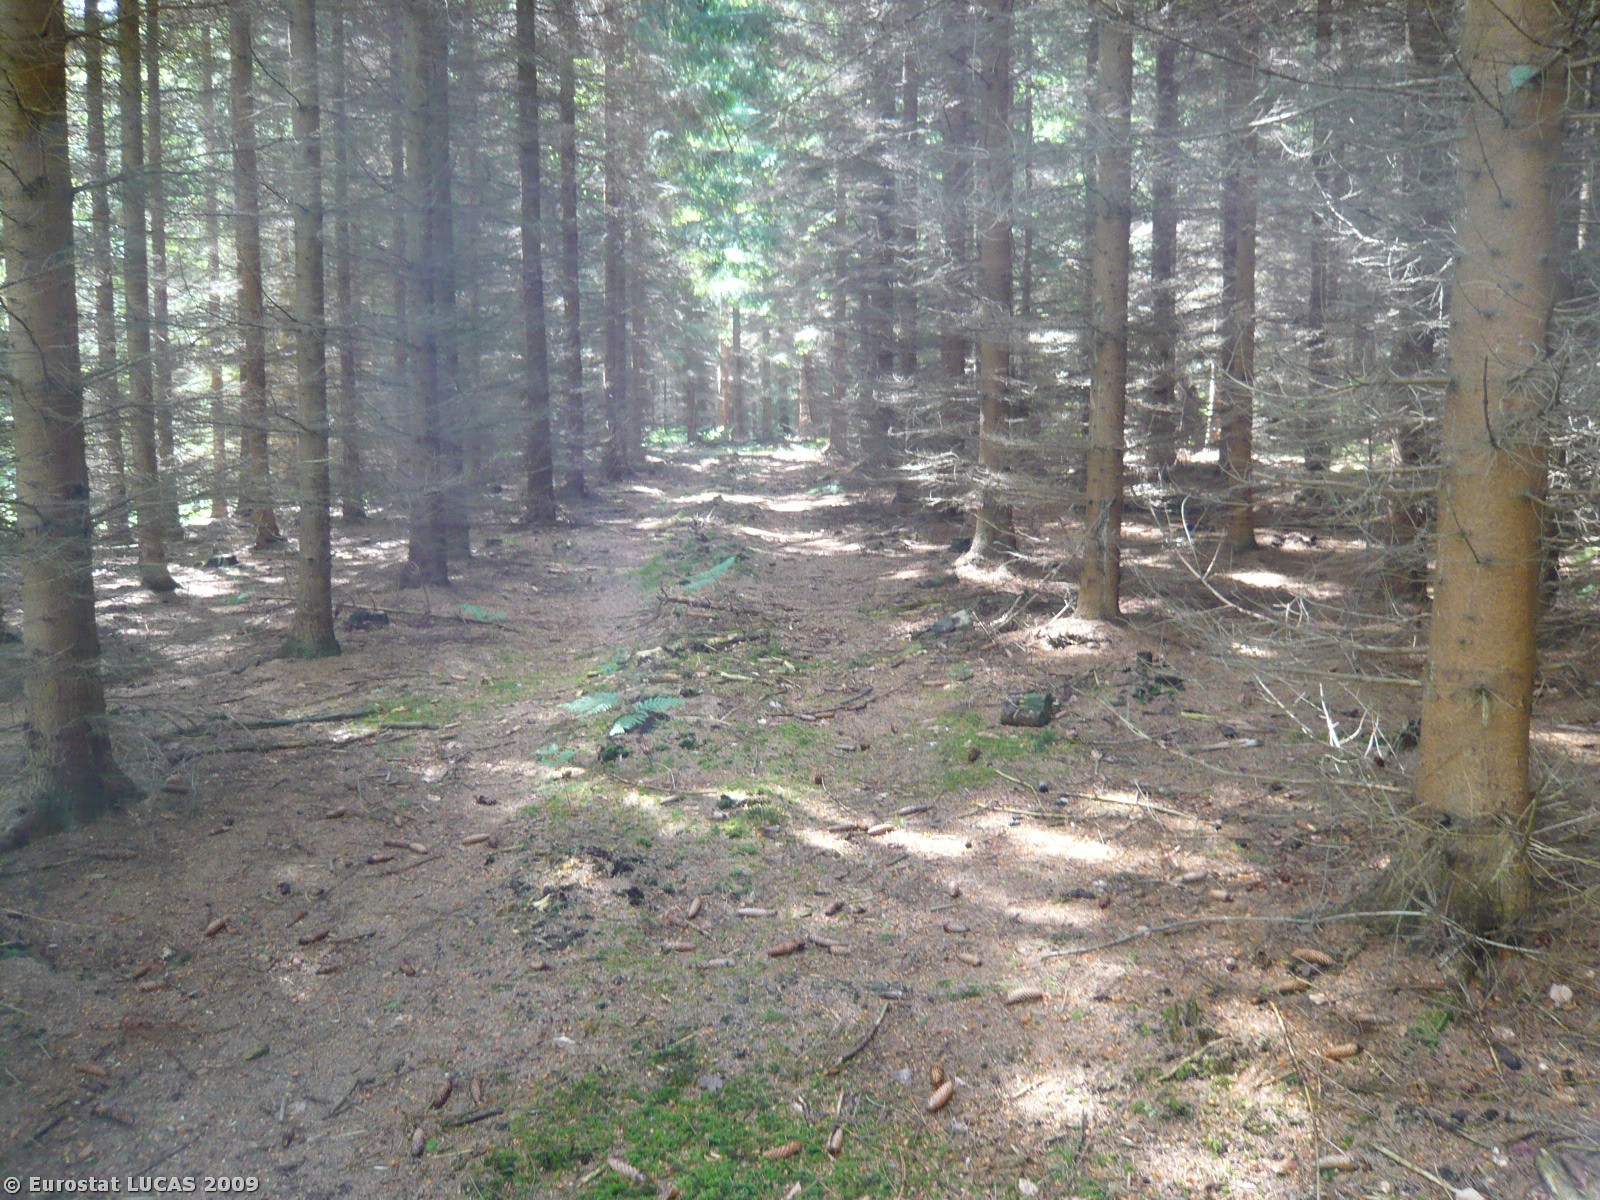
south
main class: Woodland
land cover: Coniferous woodland
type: hemiboreal forest and nemoral coniferous forest and mixed broadleaved-coniferous forest
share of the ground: > 75 %
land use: Forestry
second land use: Road transport
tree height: > 5 m
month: June
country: DK
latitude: 55.1888
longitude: 11.6166
